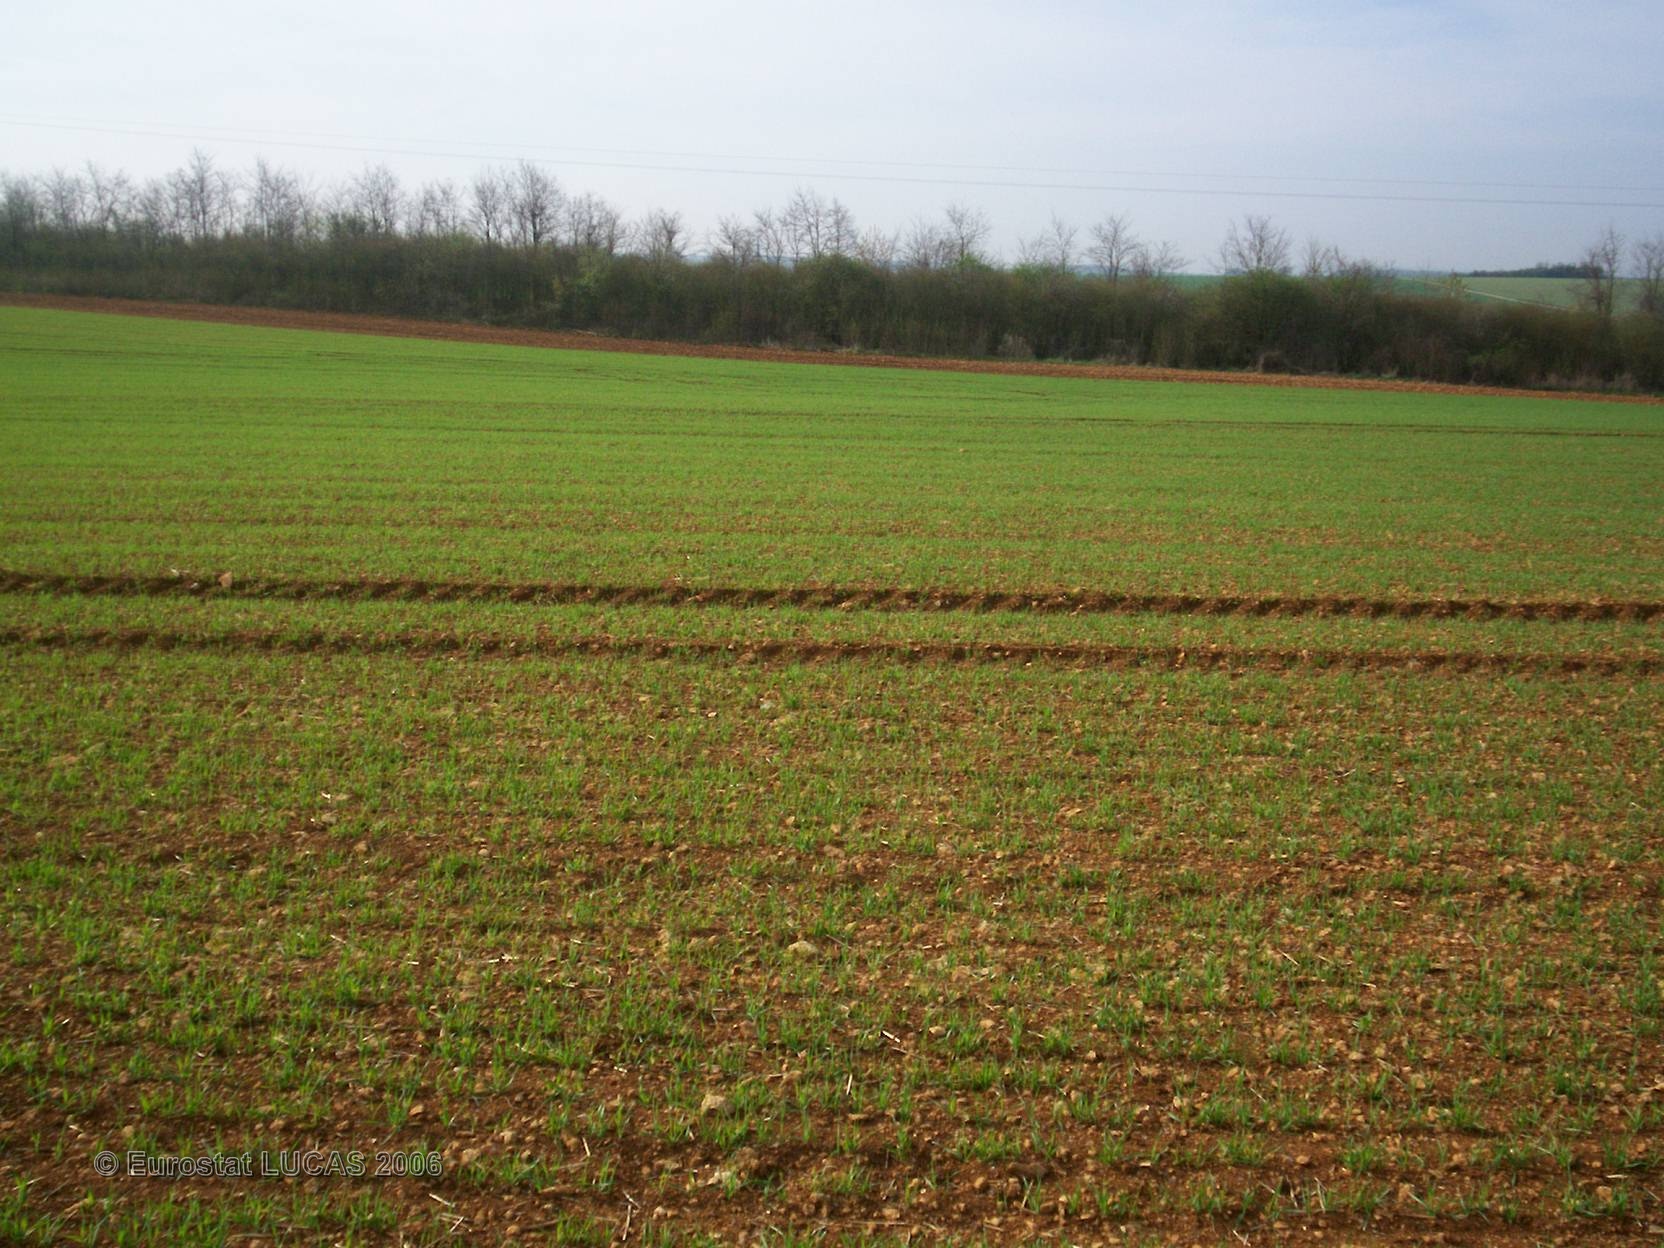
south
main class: Cropland
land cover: Barley
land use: Agriculture (excluding fallow land and kitchen gardens)
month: April
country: FR
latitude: 48.9037
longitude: 5.8931
